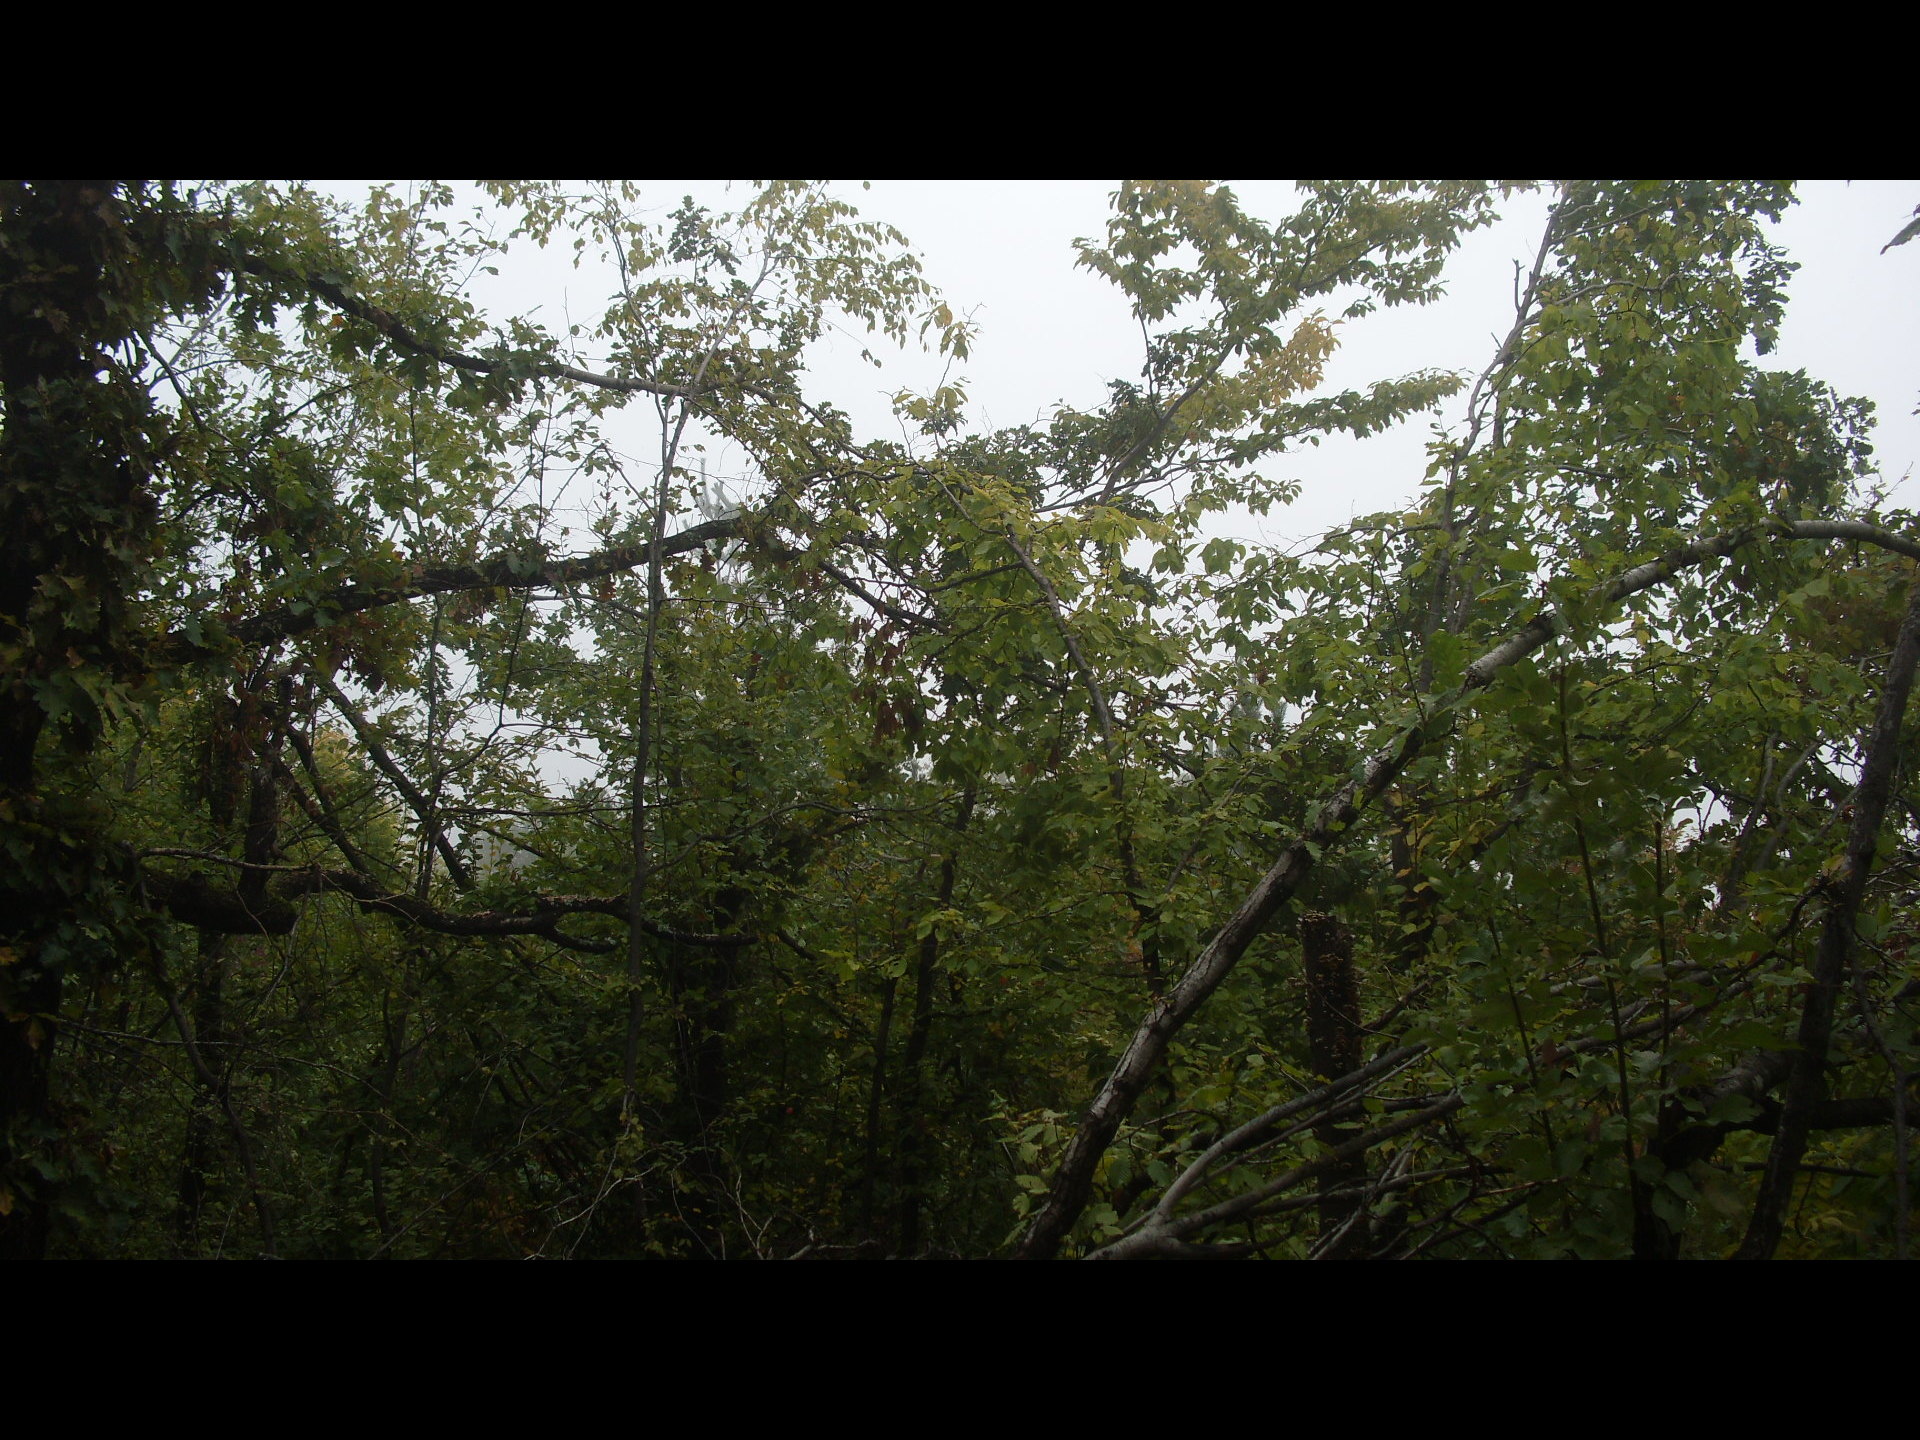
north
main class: Woodland
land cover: Broadleaved woodland
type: mesophytic deciduous forest
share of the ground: > 75 %
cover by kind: broadleaved forest trees 75 %, herbaceous plants 20 %, shrubs 5 %
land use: Forestry
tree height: > 5 m
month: October
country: BG
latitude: 43.6412
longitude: 22.5401
